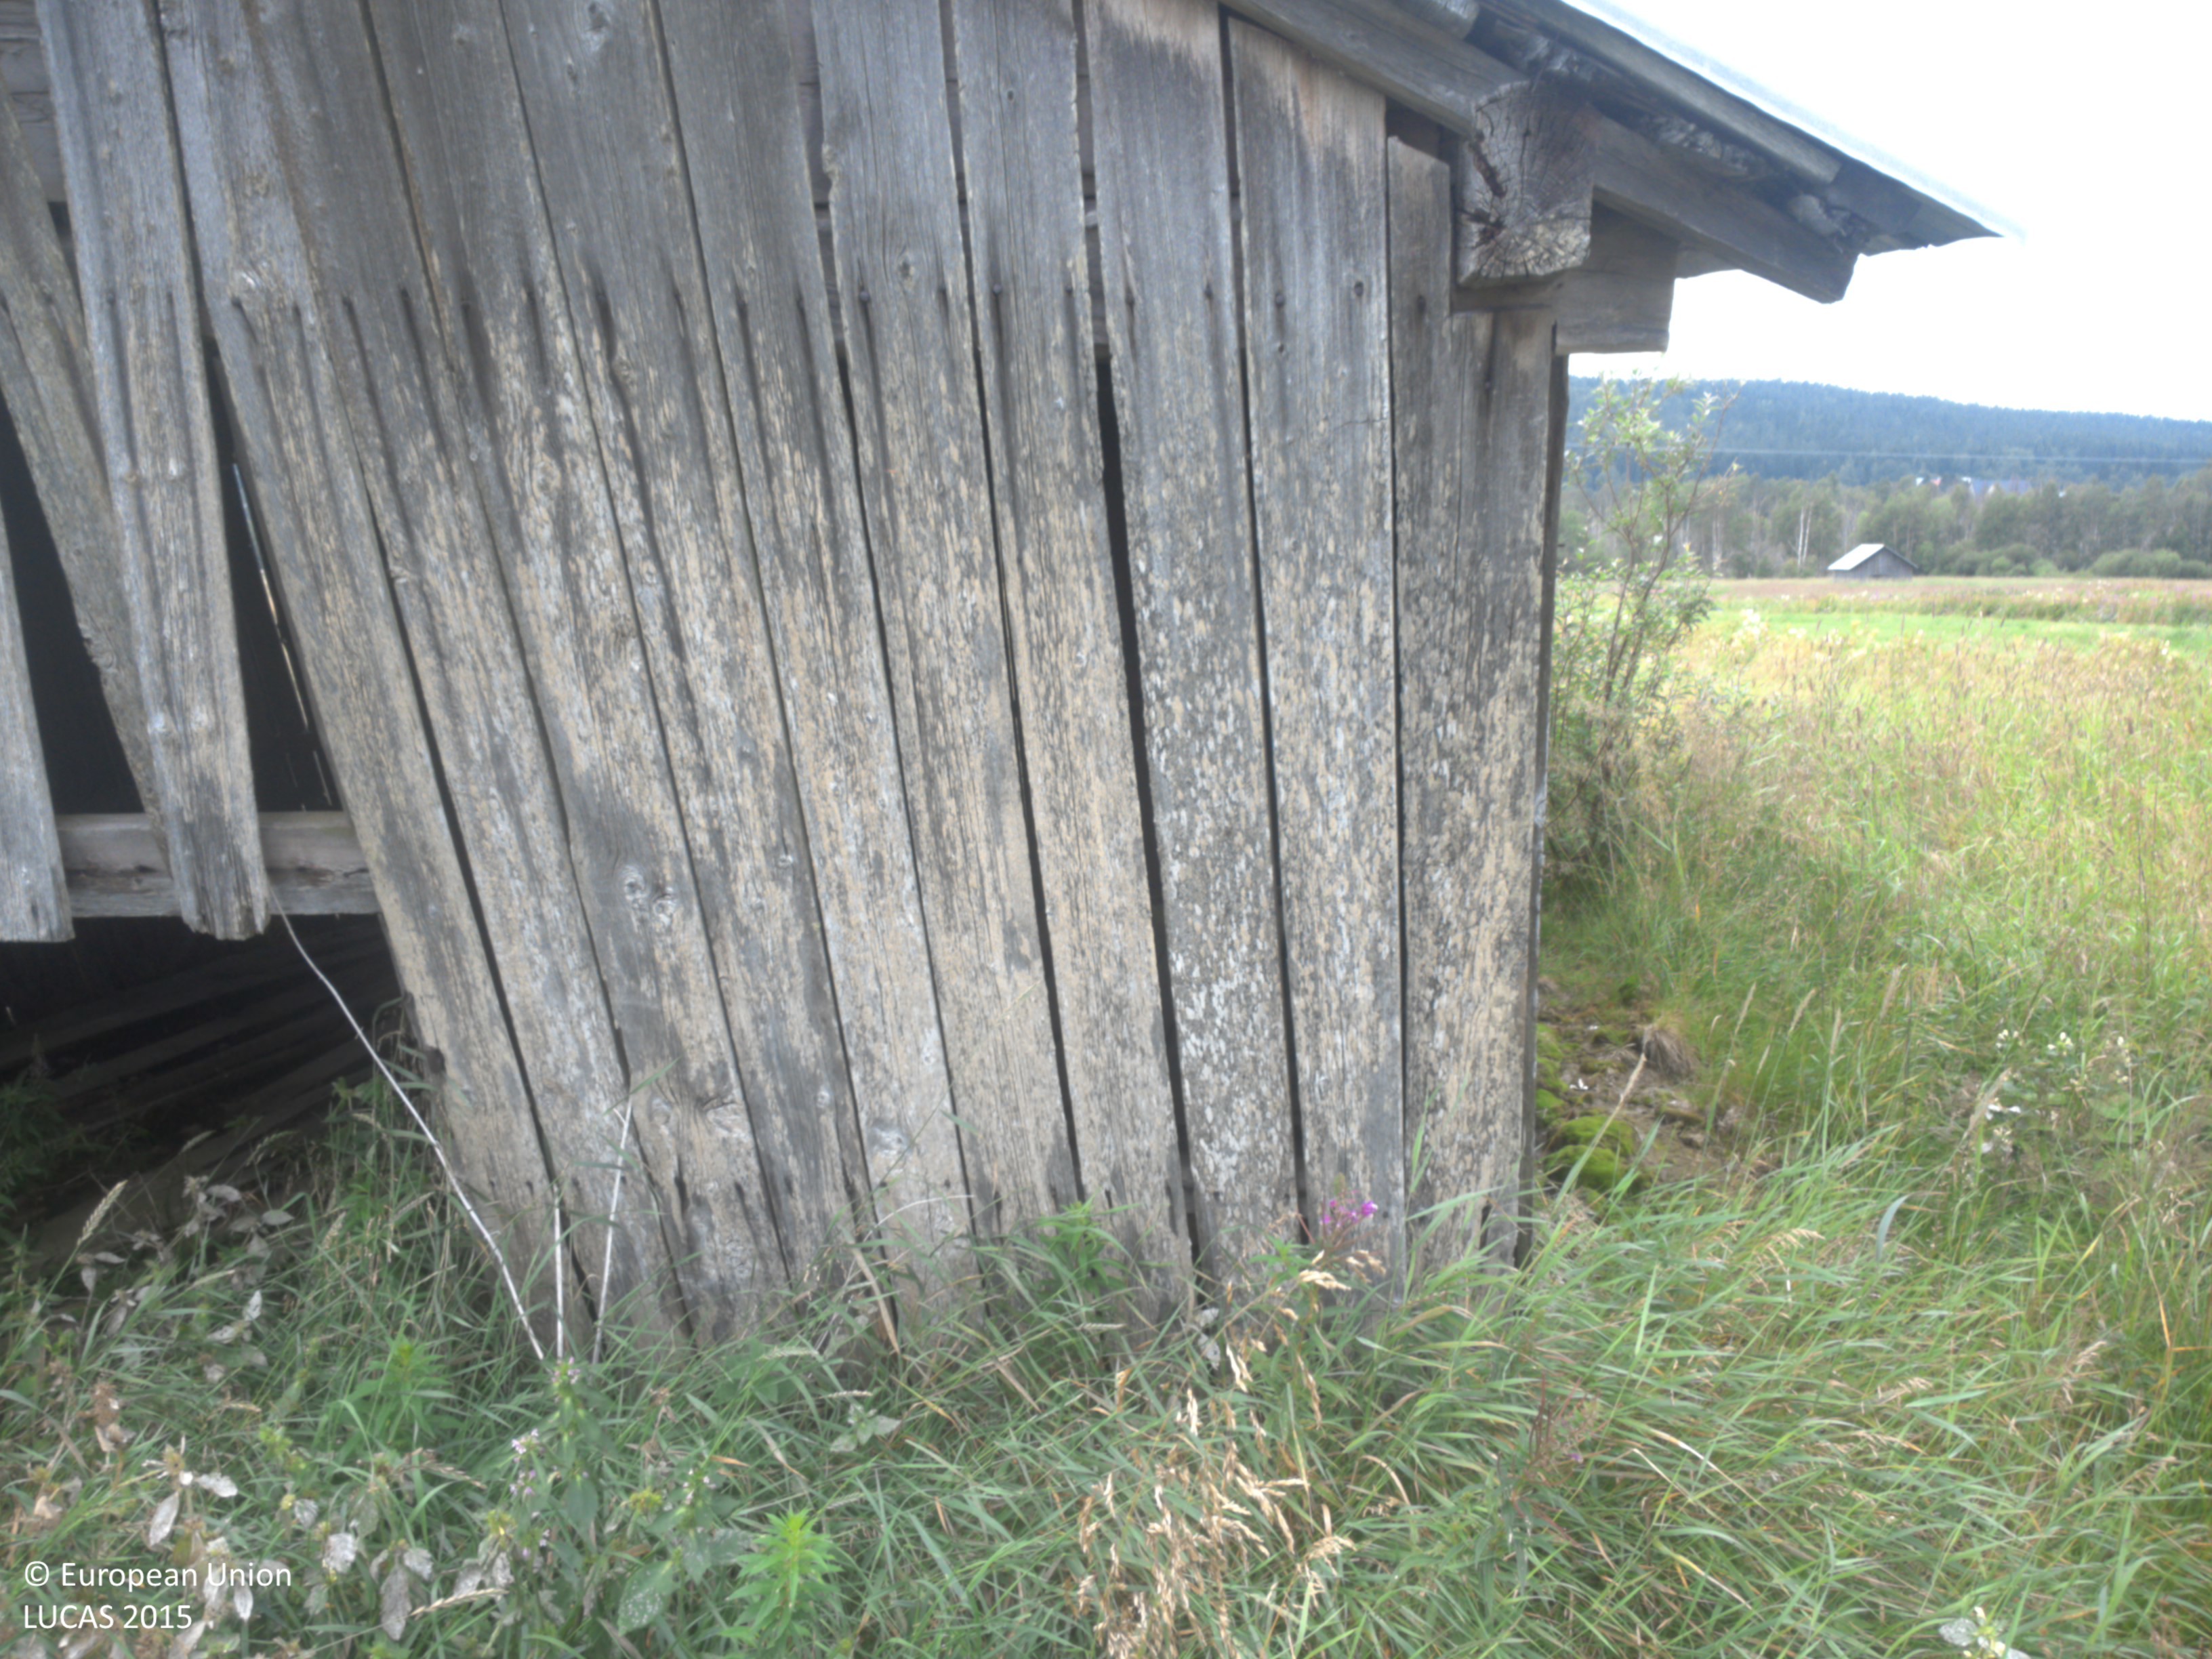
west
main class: Grassland
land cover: Spontaneously vegetated surfaces
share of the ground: > 75 %
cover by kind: herbaceous plants 100 %
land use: Agriculture (excluding fallow land and kitchen gardens)
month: August
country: SE
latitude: 63.7810
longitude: 19.8596
